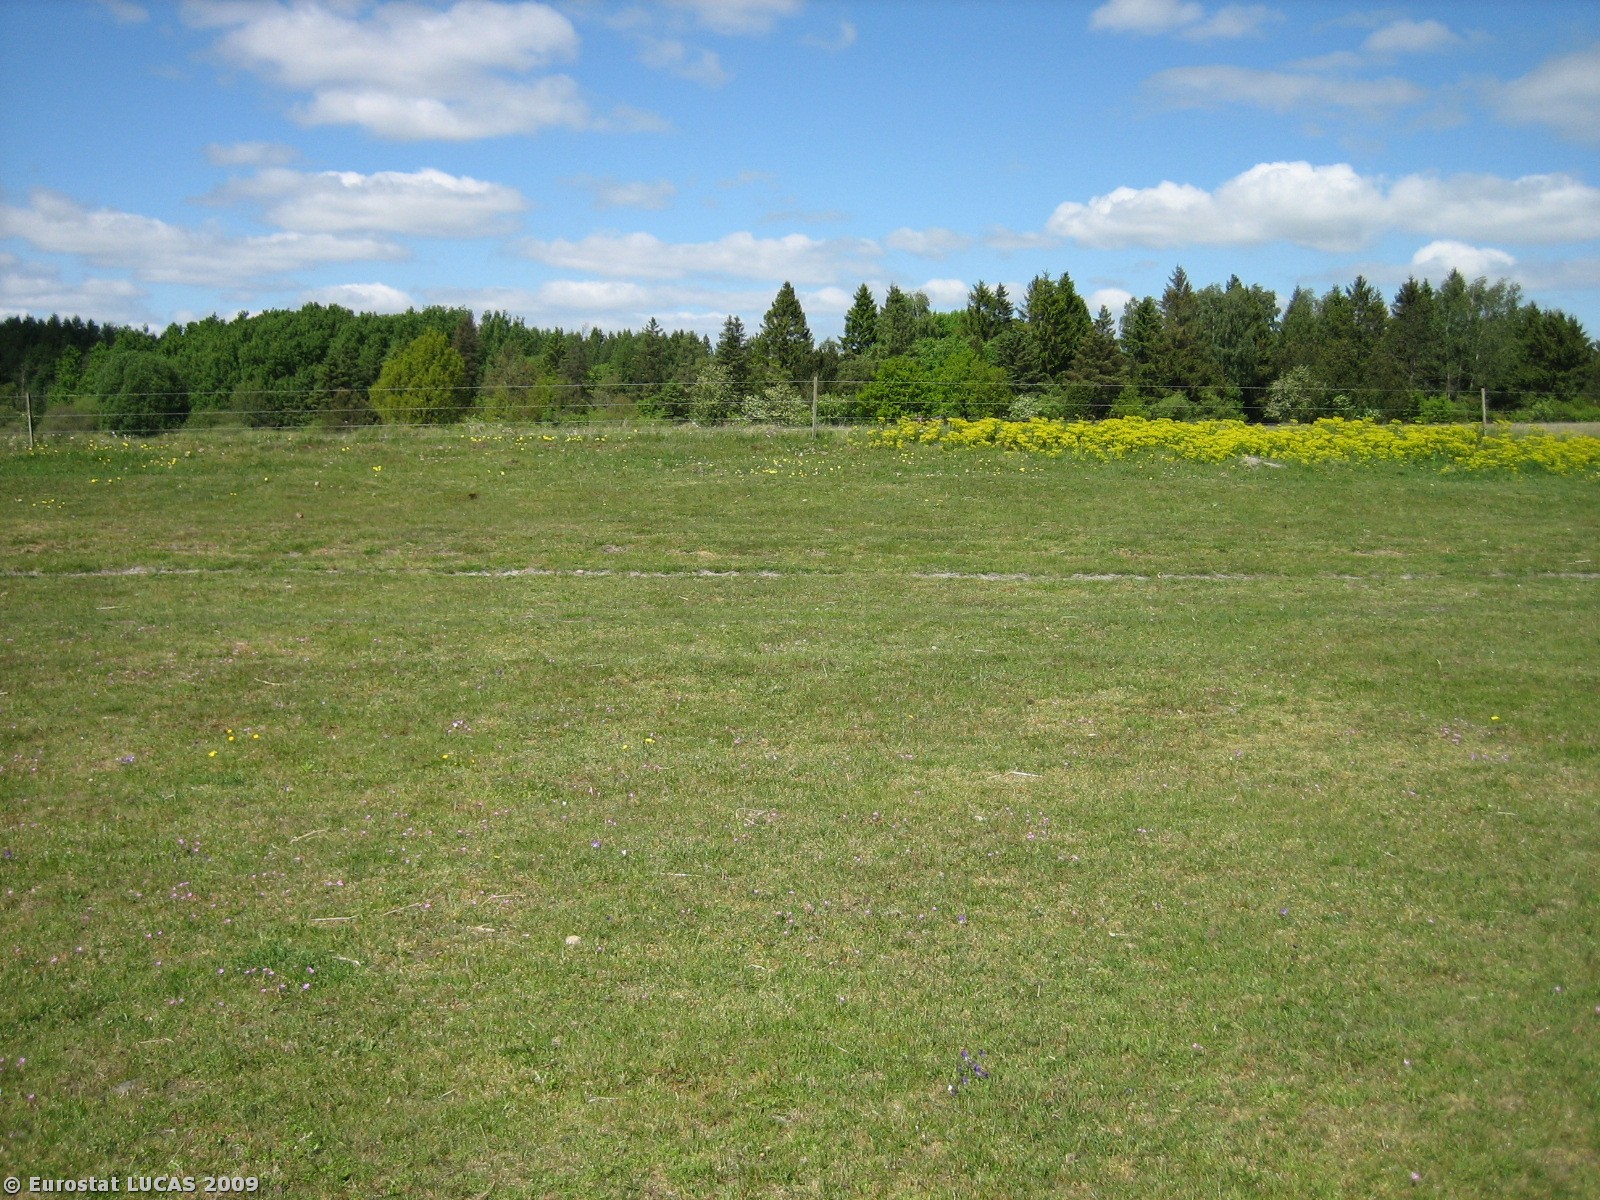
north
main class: Grassland
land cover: Grassland without tree/shrub cover
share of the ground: > 75 %
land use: Residential
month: May
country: DK
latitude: 56.0399
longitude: 8.9899
